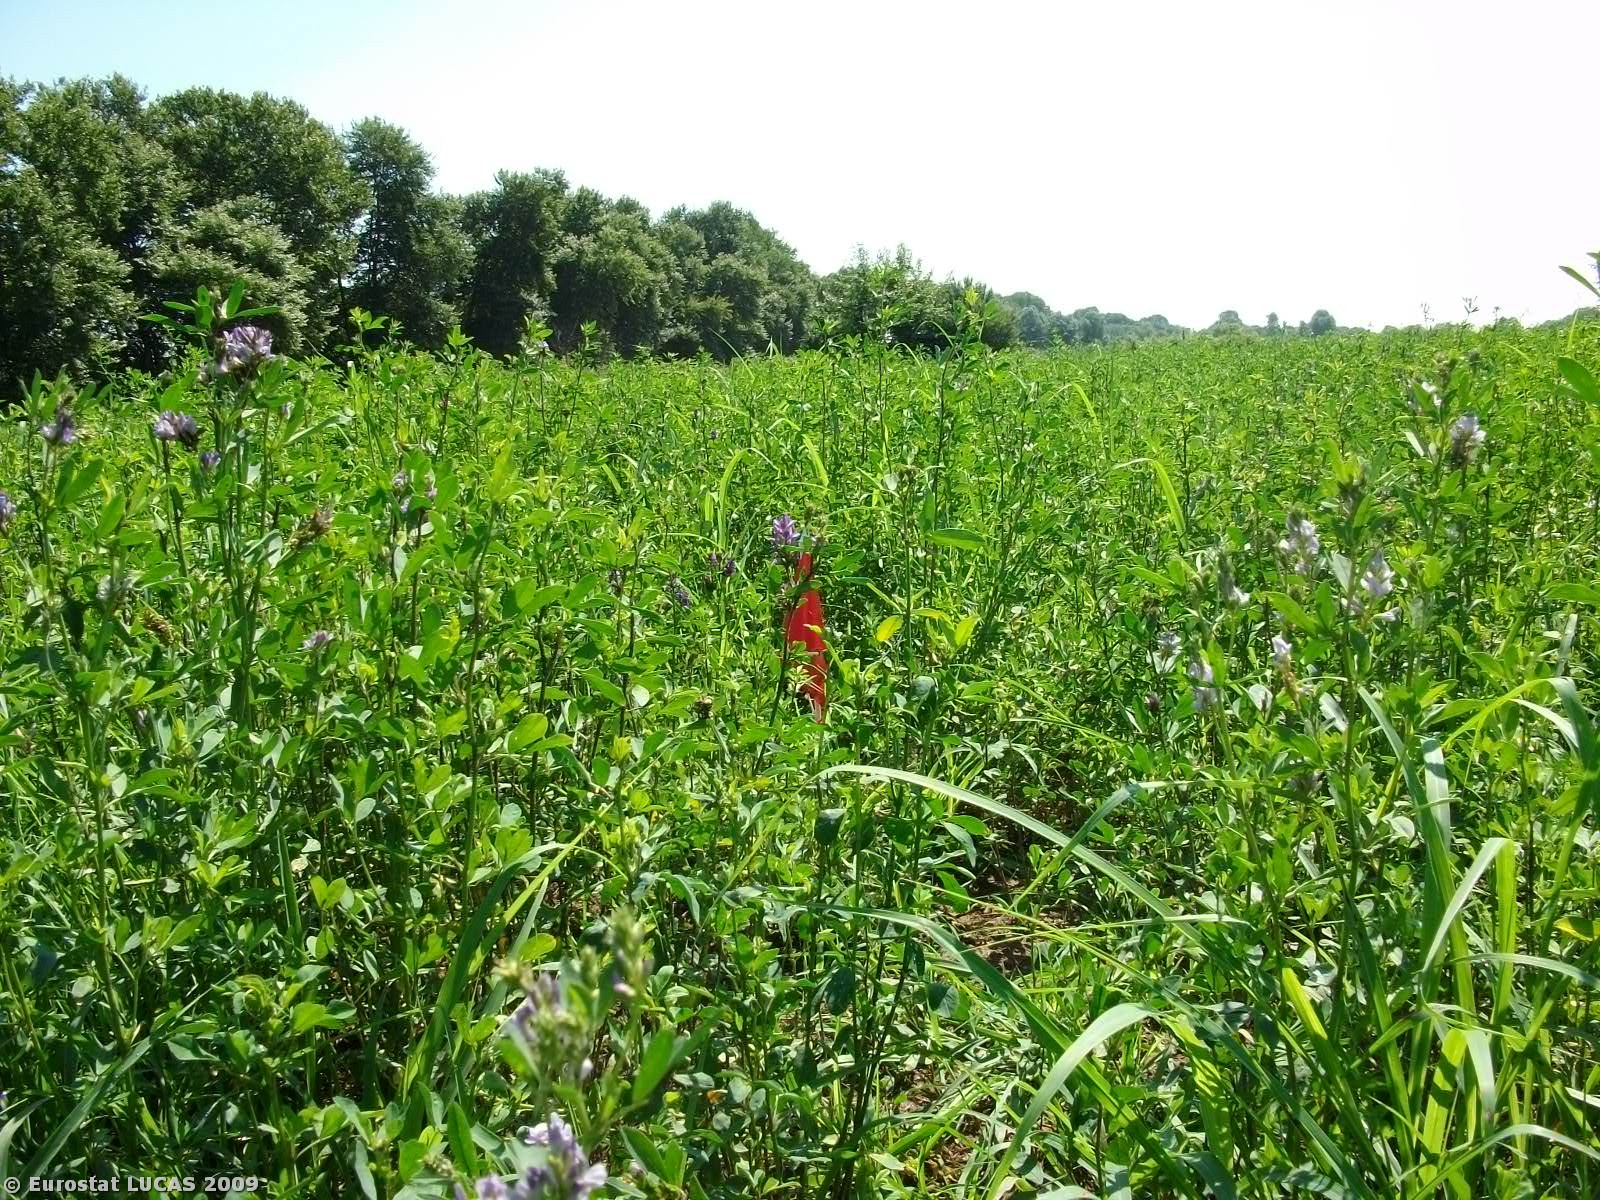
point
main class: Cropland
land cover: Clovers
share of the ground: > 75 %
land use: Agriculture (excluding fallow land and kitchen gardens)
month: July
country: GR
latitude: 39.5285
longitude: 21.6976
